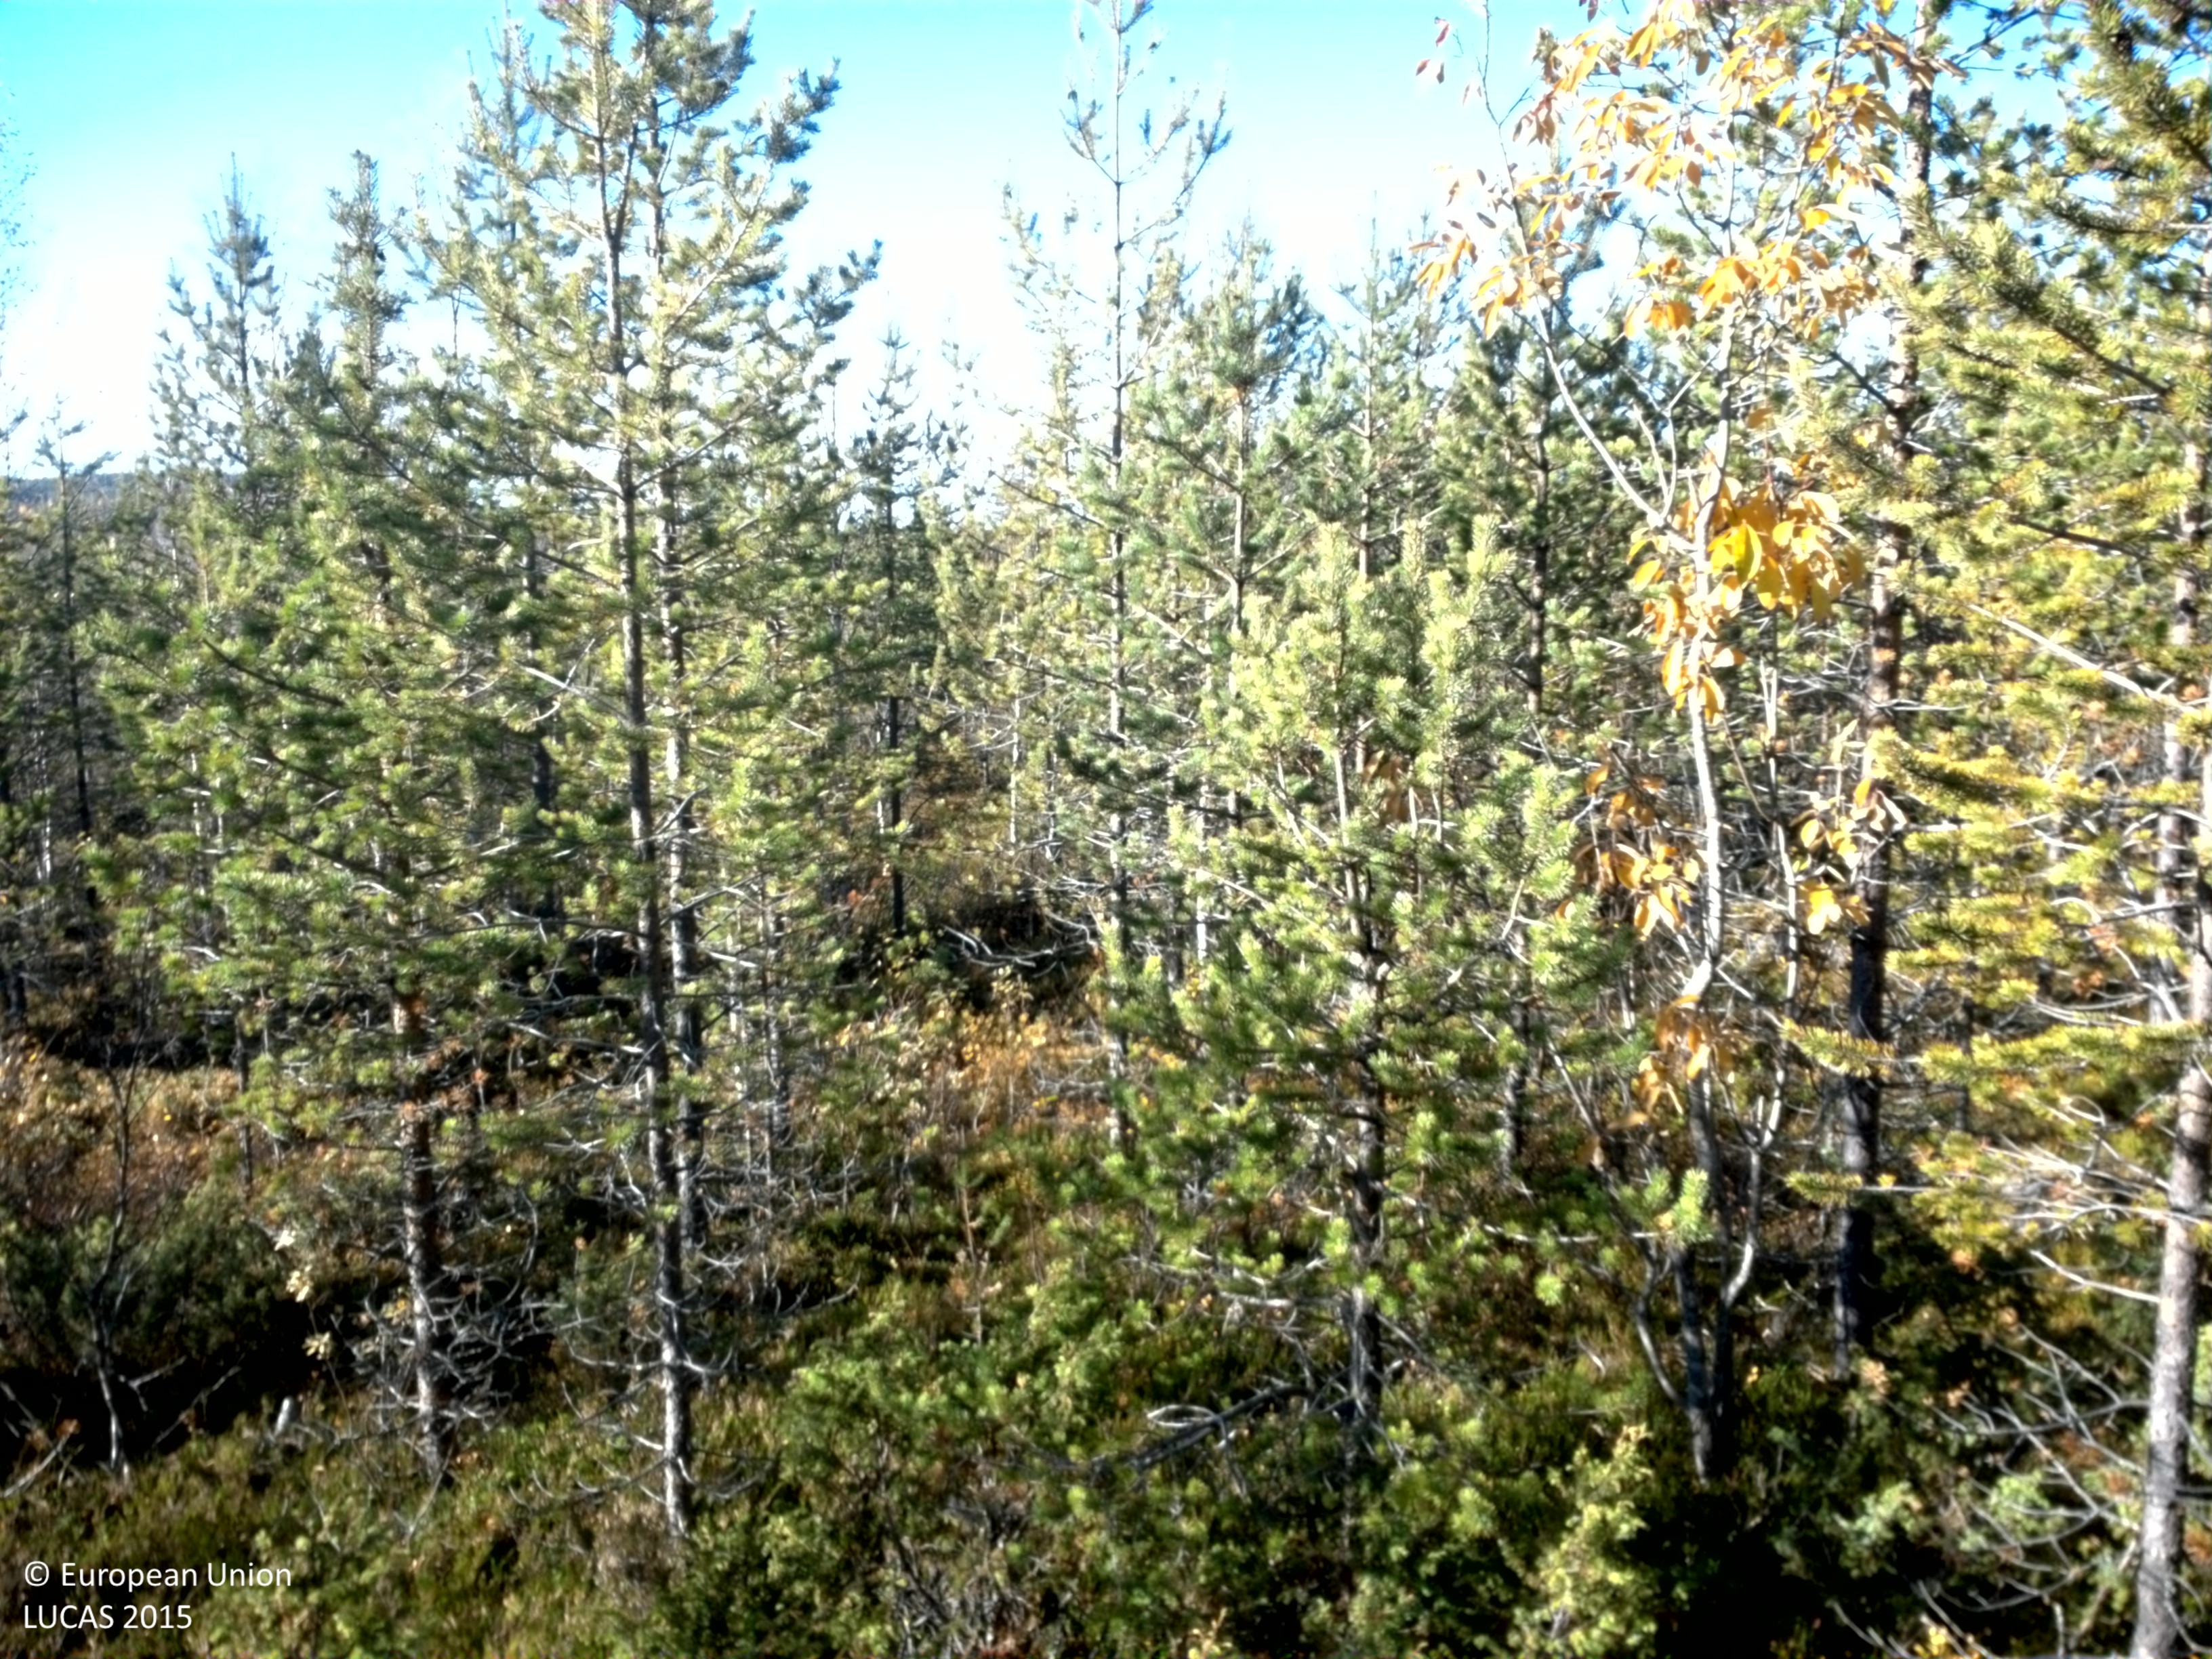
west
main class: Woodland
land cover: Pine dominated coniferous woodland
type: boreal forest
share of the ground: 50 - 75 %
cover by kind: coniferous forest trees 45 %, shrubs 30 %, lichens and mosses 15 %, broadleaved forest trees 5 %, herbaceous plants 5 %
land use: Forestry
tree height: > 5 m
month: October
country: SE
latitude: 64.8244
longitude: 17.4020
